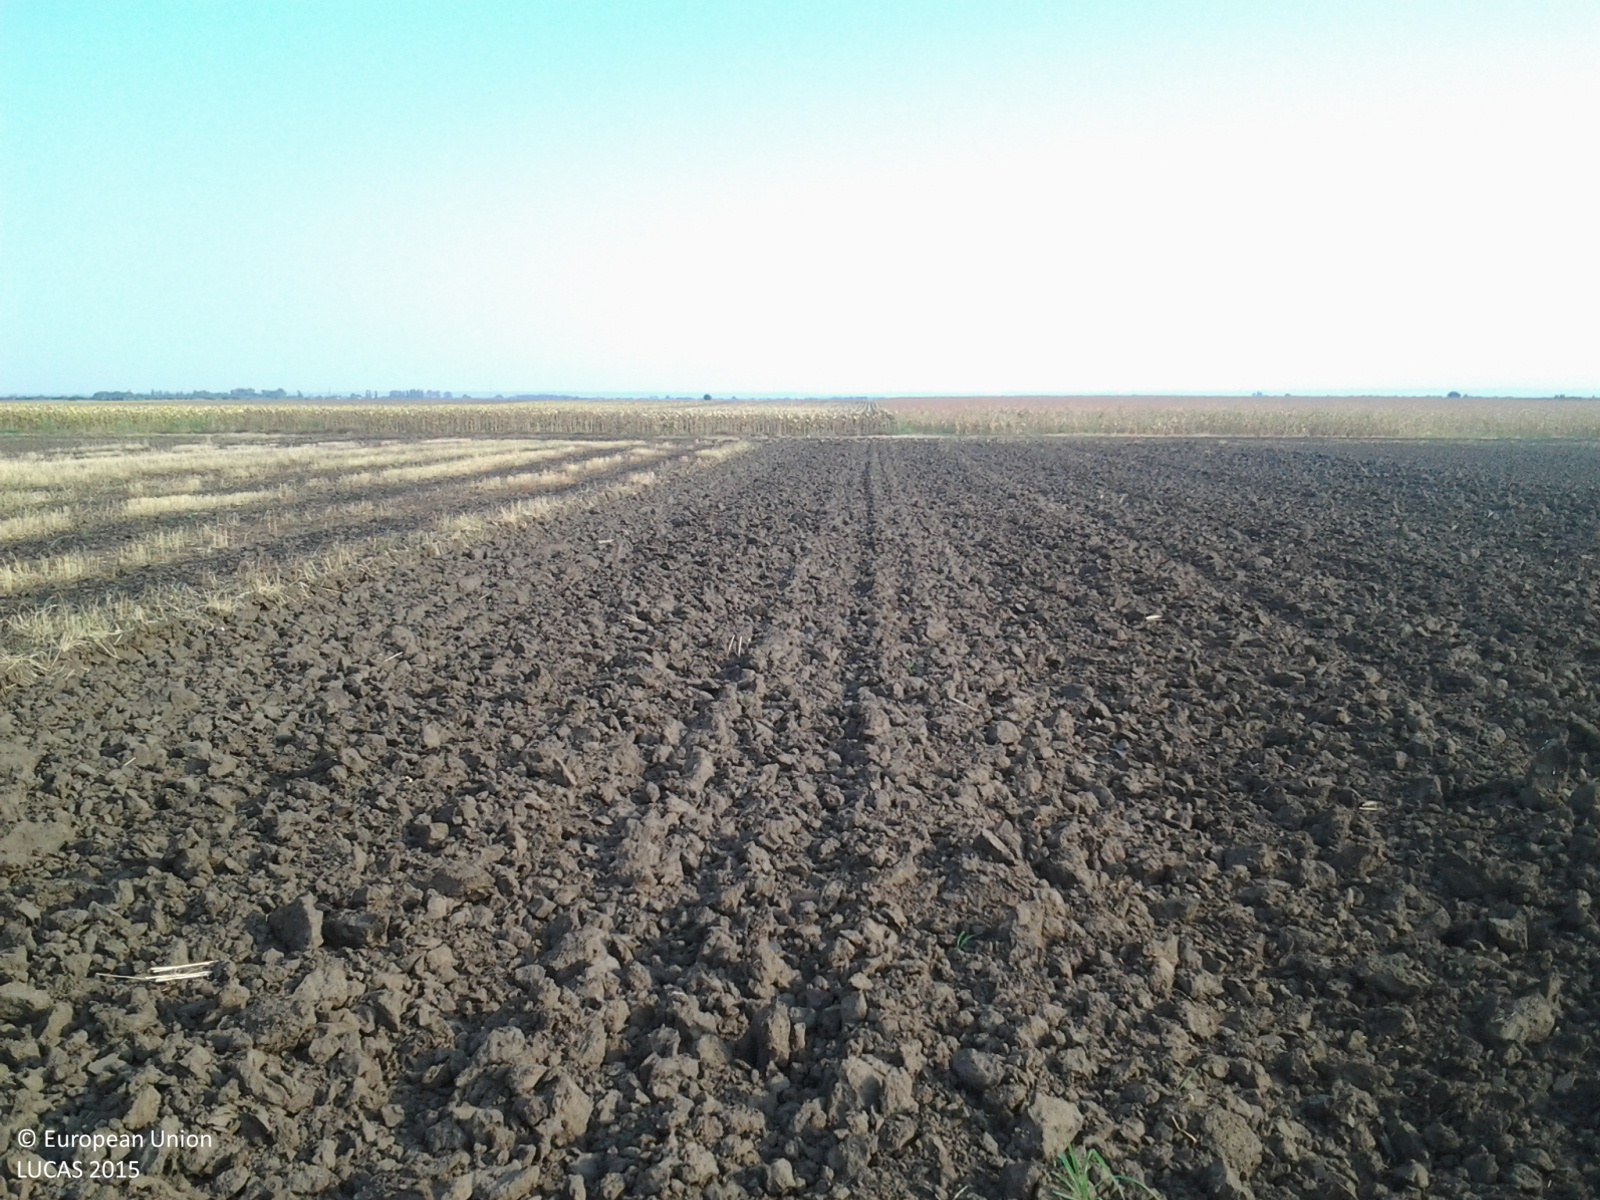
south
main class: Cropland
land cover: Common wheat
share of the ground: < 10 %
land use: Agriculture (excluding fallow land and kitchen gardens)
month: August
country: RO
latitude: 43.9617
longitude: 23.0405
